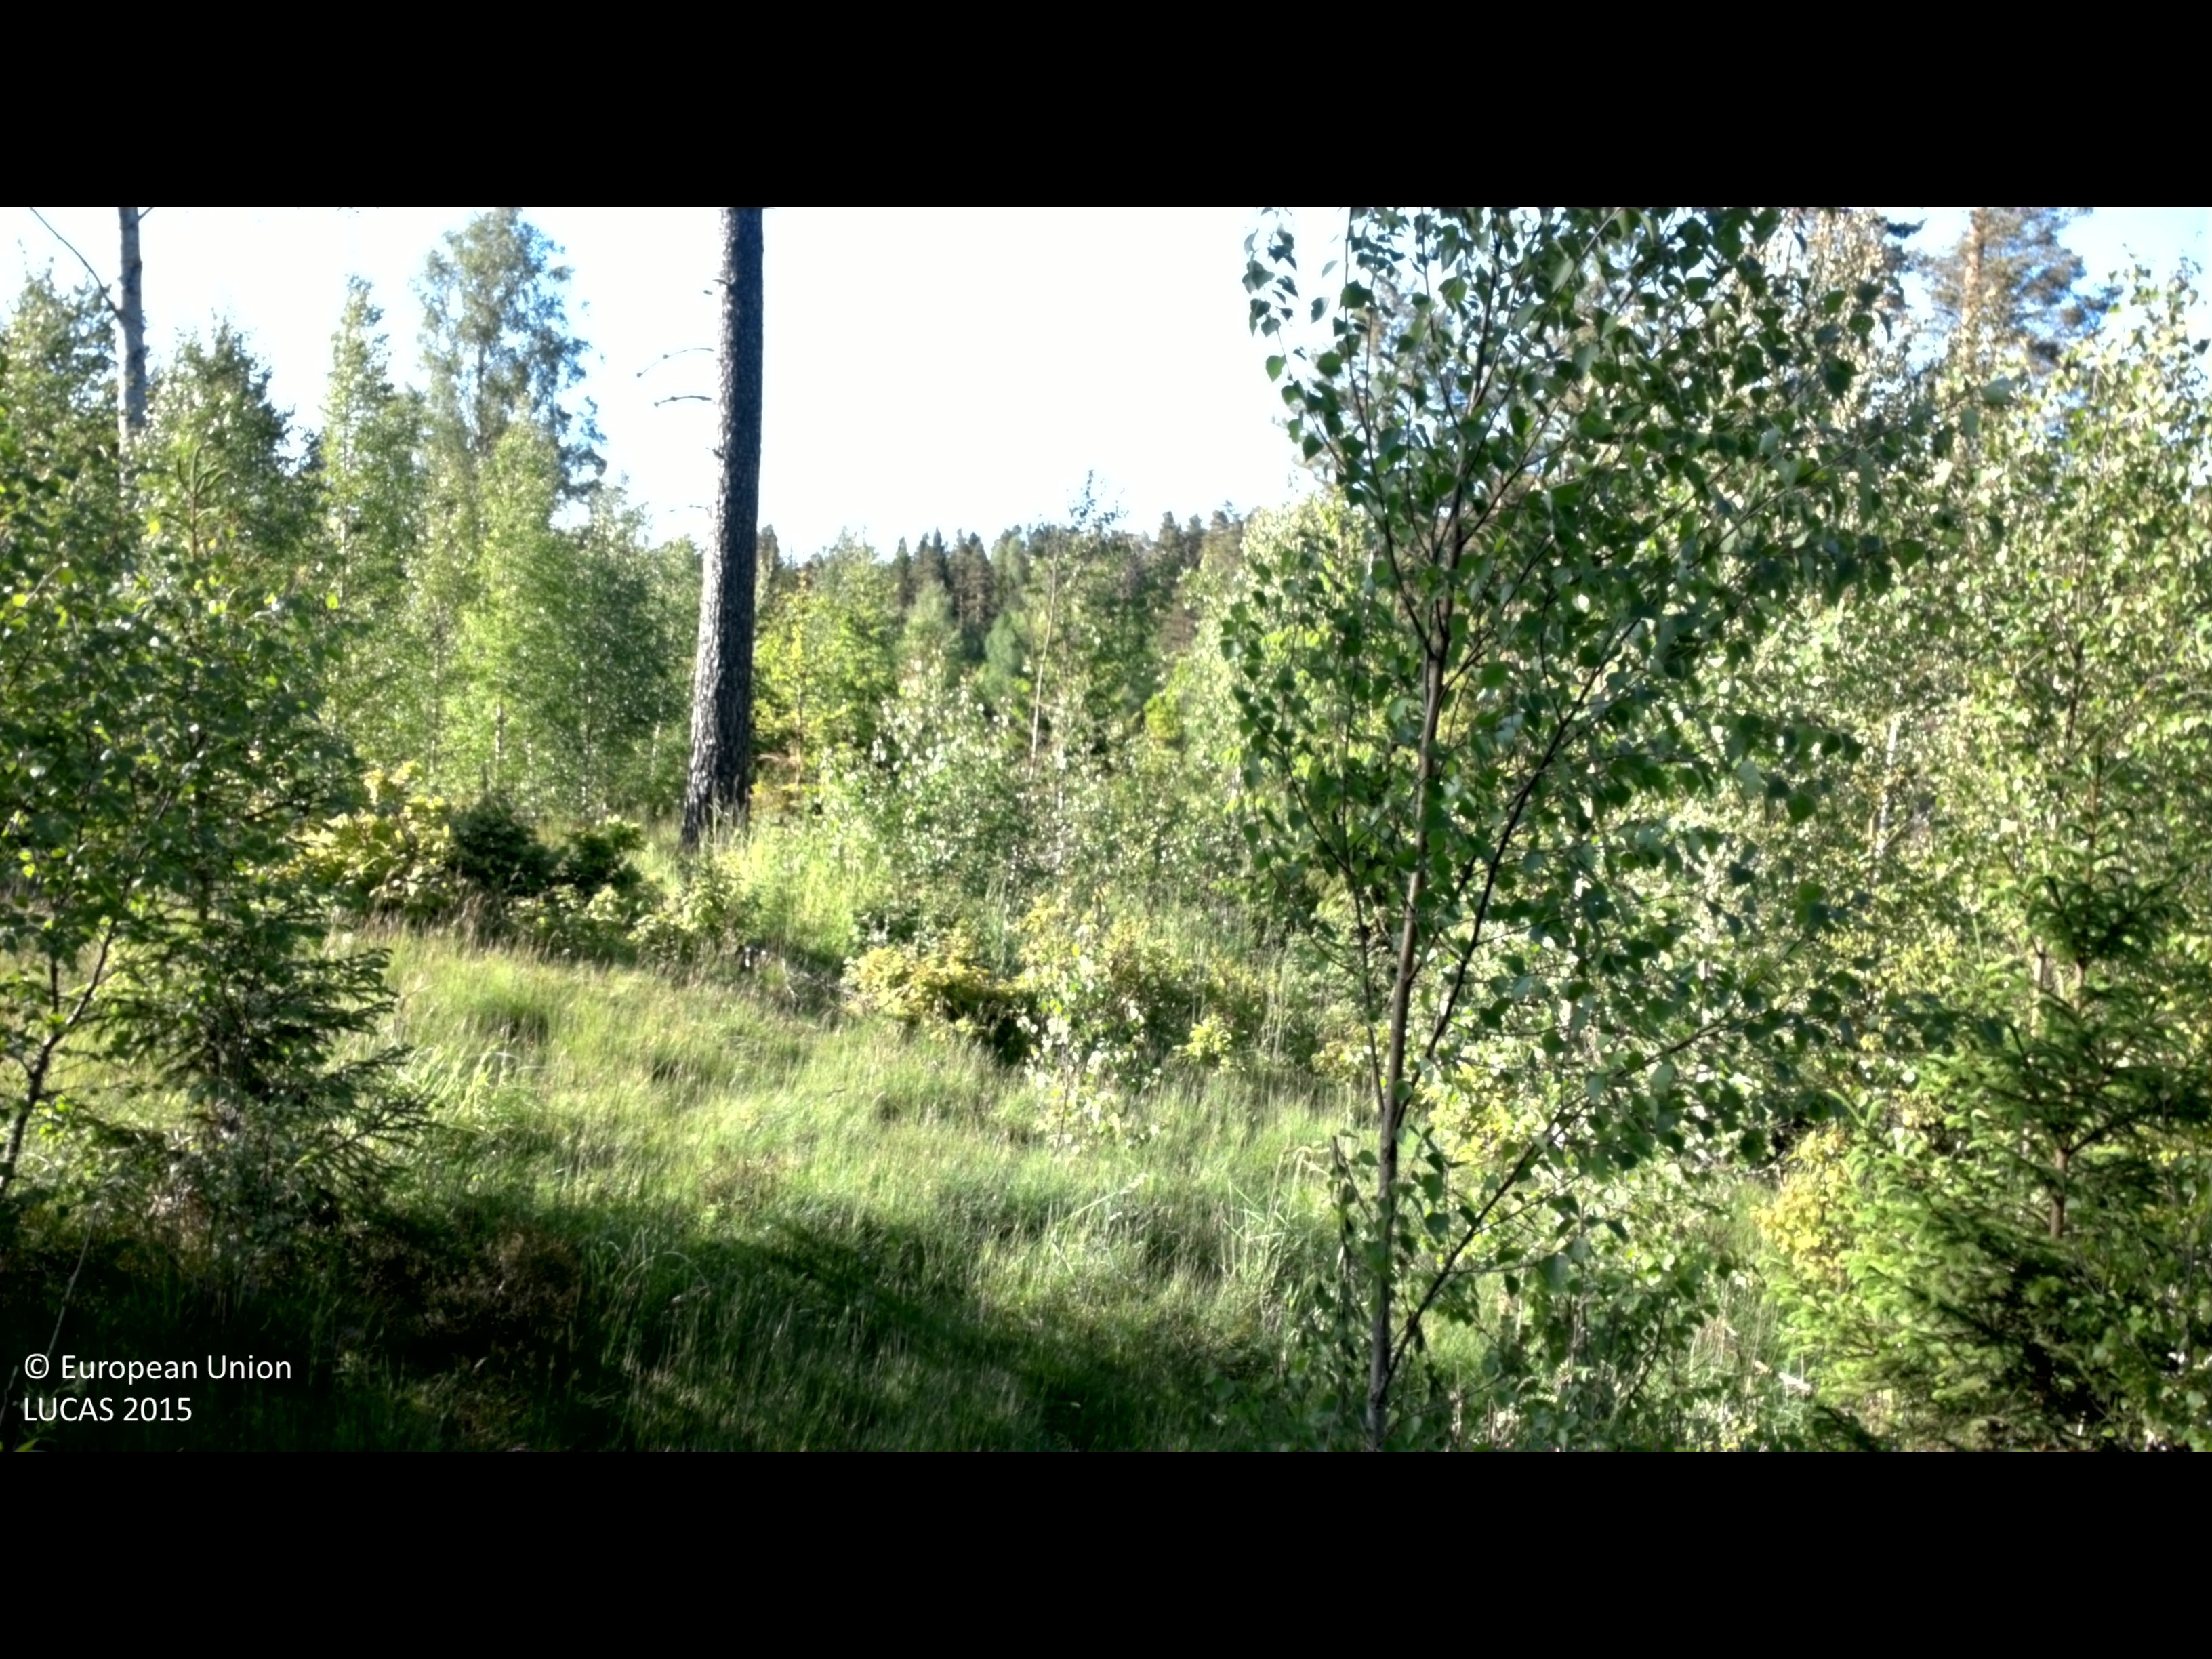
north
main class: Woodland
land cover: Spruce dominated mixed woodland
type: hemiboreal forest and nemoral coniferous forest and mixed broadleaved-coniferous forest
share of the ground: 25 - 50 %
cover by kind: herbaceous plants 40 %, shrubs 25 %, coniferous forest trees 20 %, broadleaved forest trees 15 %
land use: Forestry
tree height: > 5 m
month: June
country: SE
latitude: 57.8413
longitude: 16.2131
